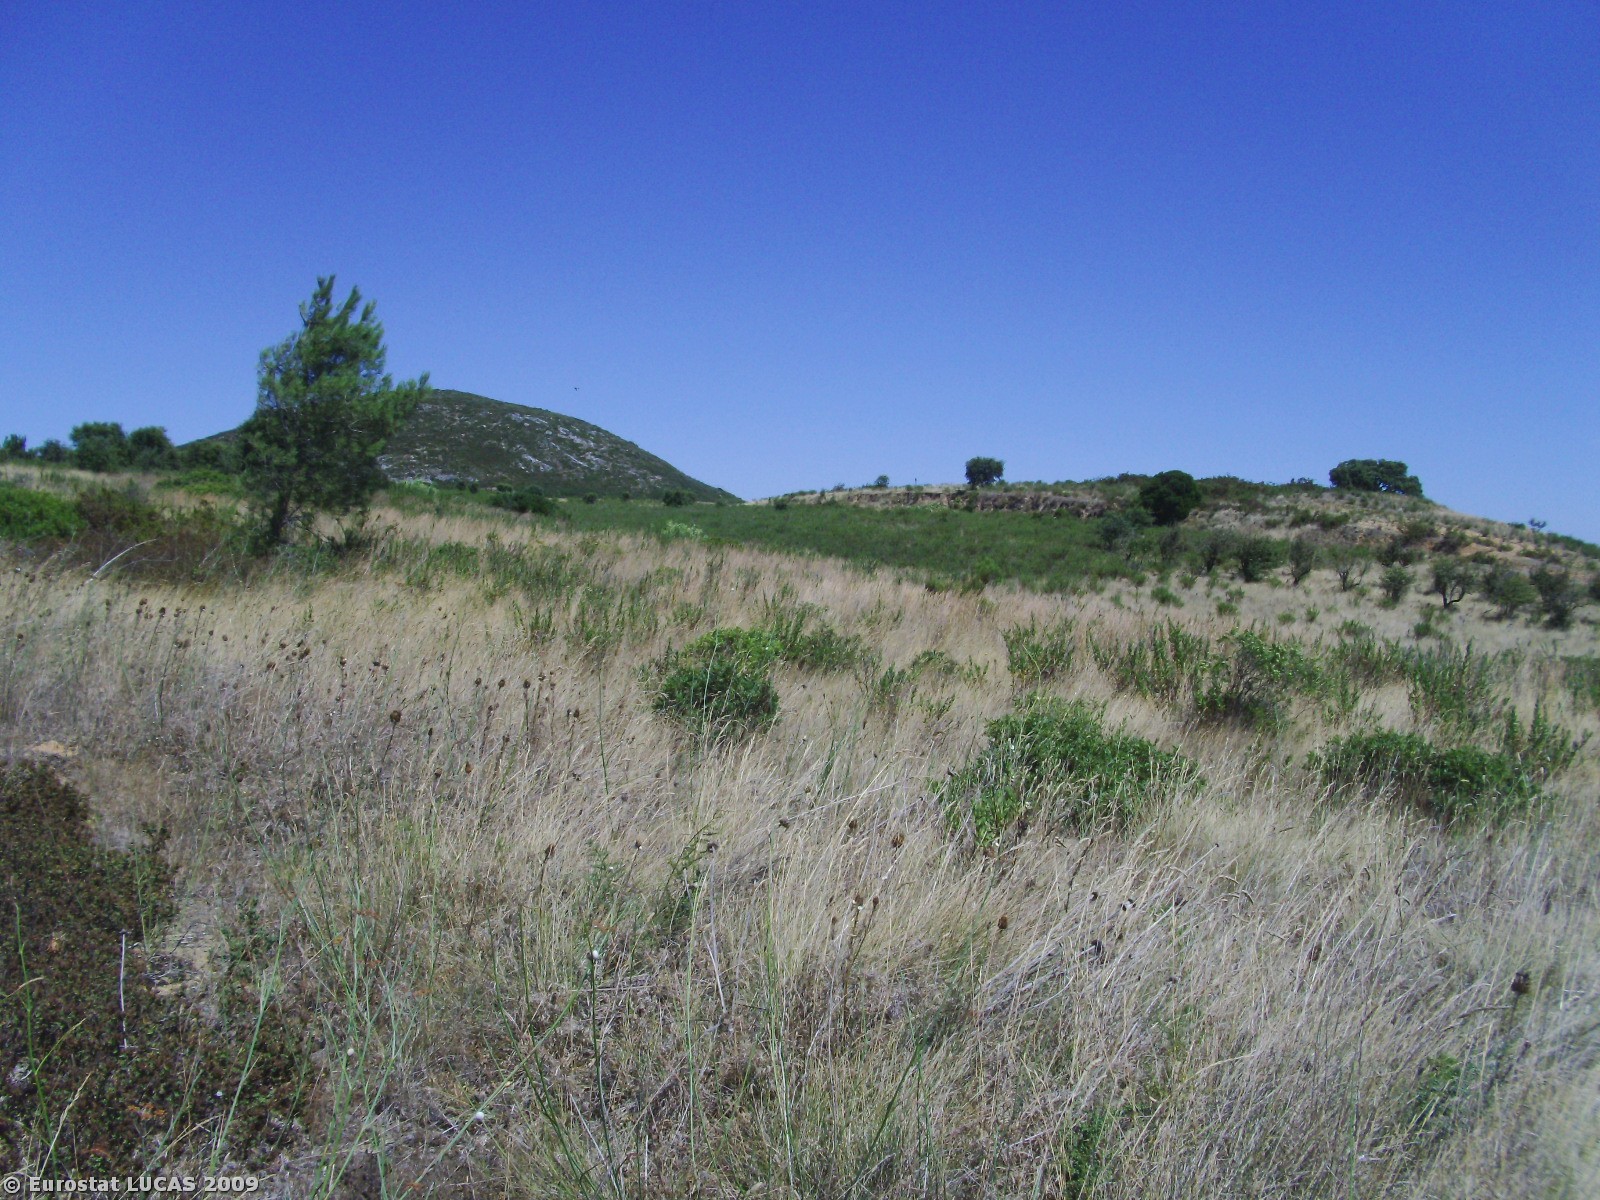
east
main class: Grassland
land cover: Spontaneously vegetated surfaces
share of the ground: > 75 %
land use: Fallow land
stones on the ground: 25 - 50 %
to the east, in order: Spontaneously vegetated surfaces
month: July
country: PT
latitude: 39.1336
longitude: -8.9938
